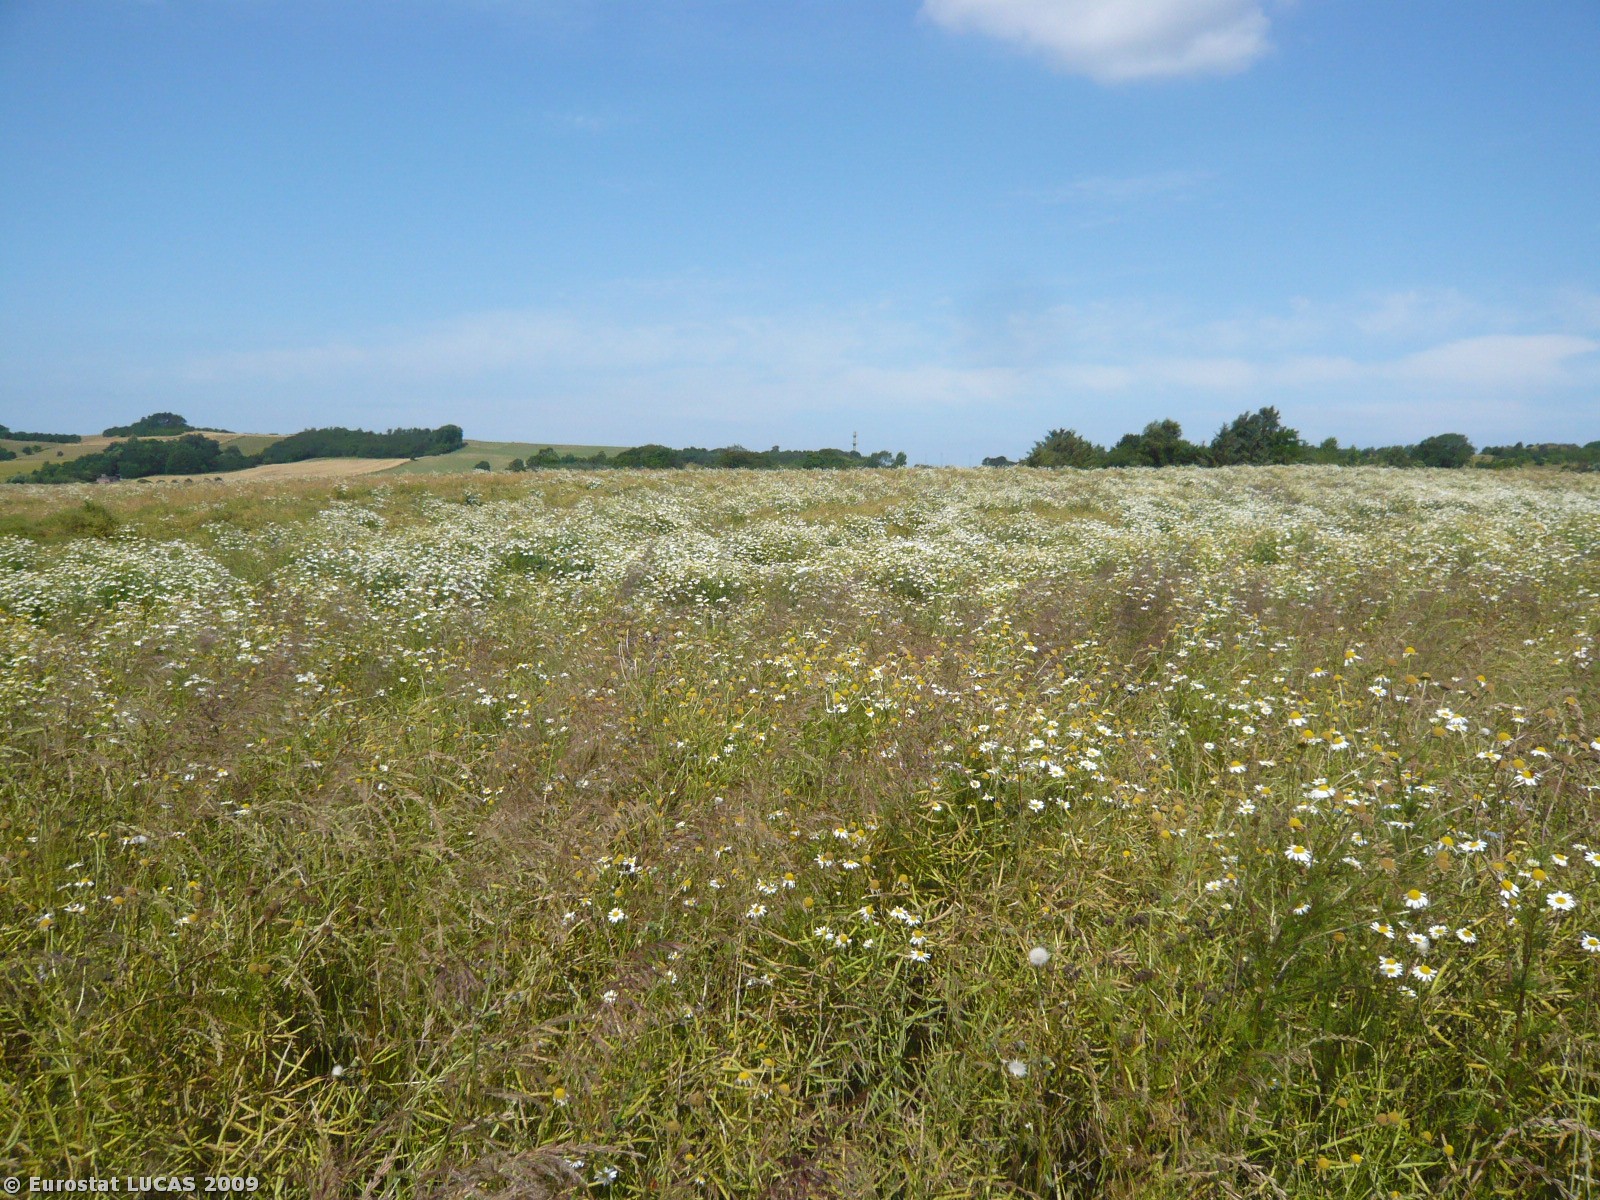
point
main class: Cropland
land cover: Rape and turnip rape
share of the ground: > 75 %
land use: Agriculture (excluding fallow land and kitchen gardens)
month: July
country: DK
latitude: 55.8200
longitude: 11.4510
